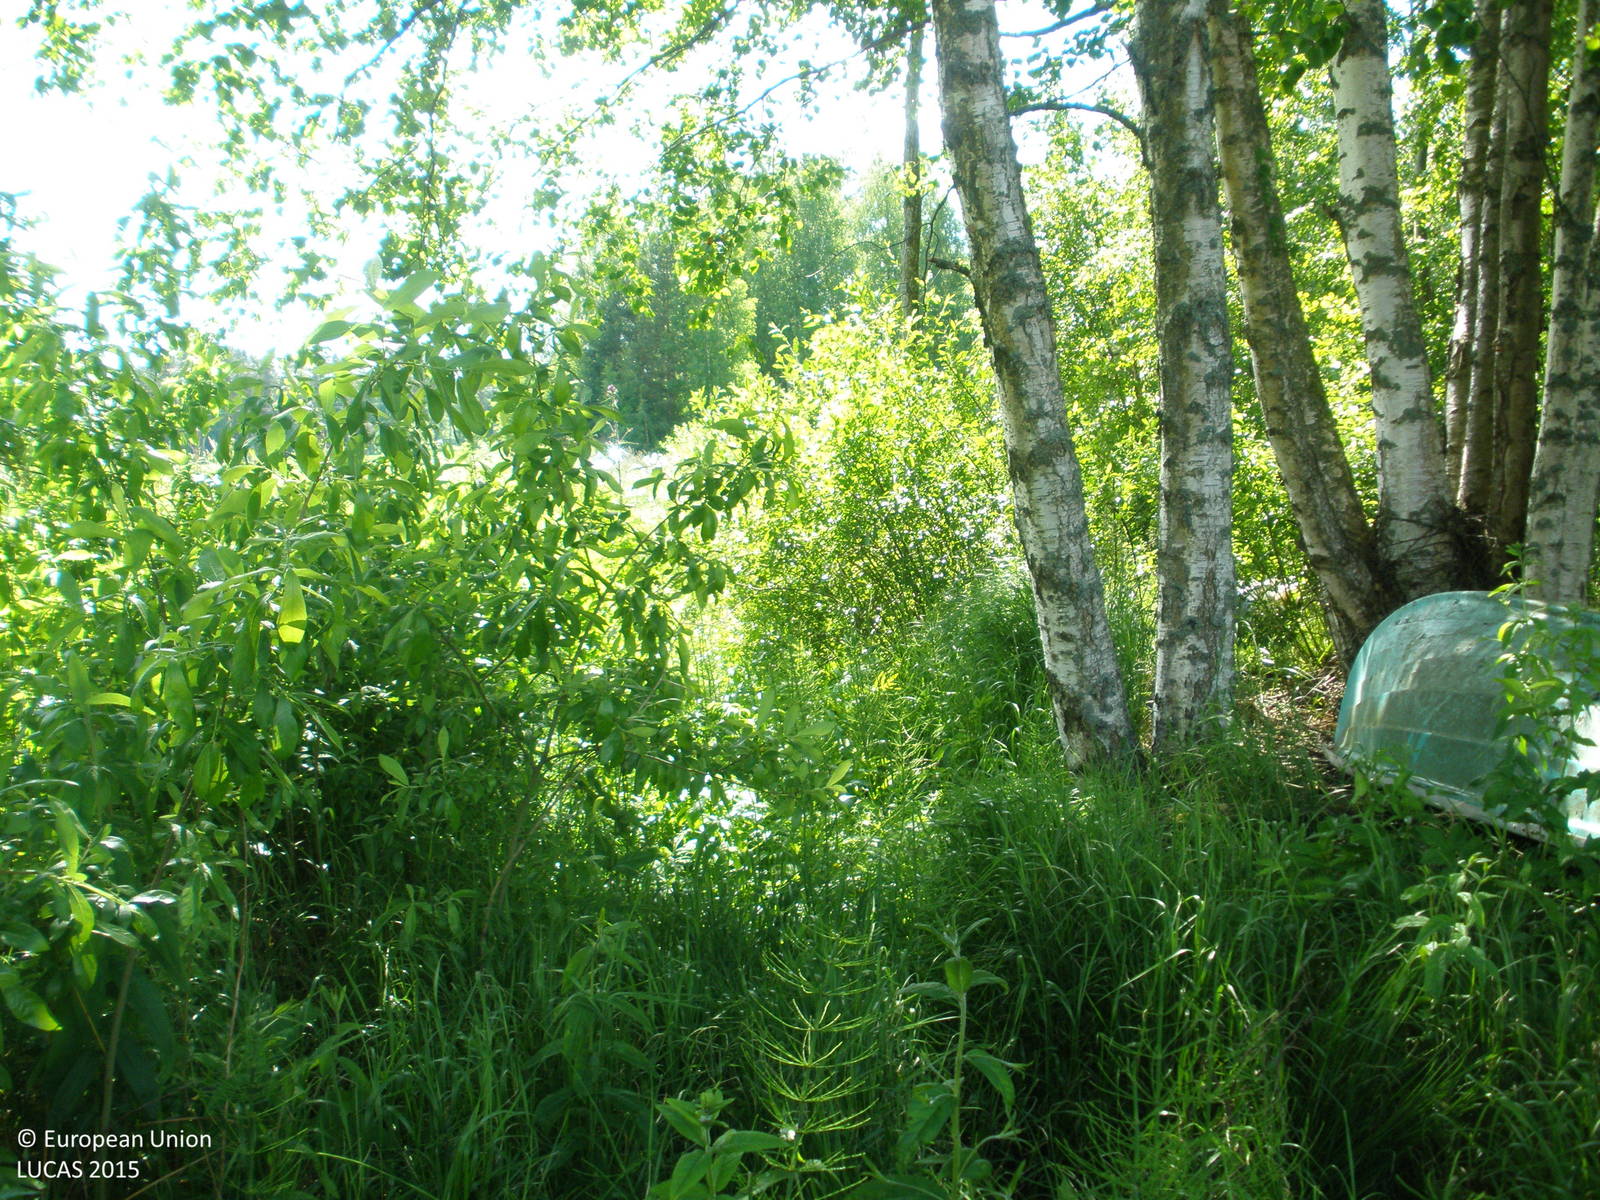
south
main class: Woodland
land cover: Broadleaved woodland
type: non-riverine alder, birch or aspen forest
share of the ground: > 75 %
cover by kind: broadleaved forest trees 80 %, herbaceous plants 20 %
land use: Forestry
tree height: > 5 m
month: June
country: FI
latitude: 61.0399
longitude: 24.1472
